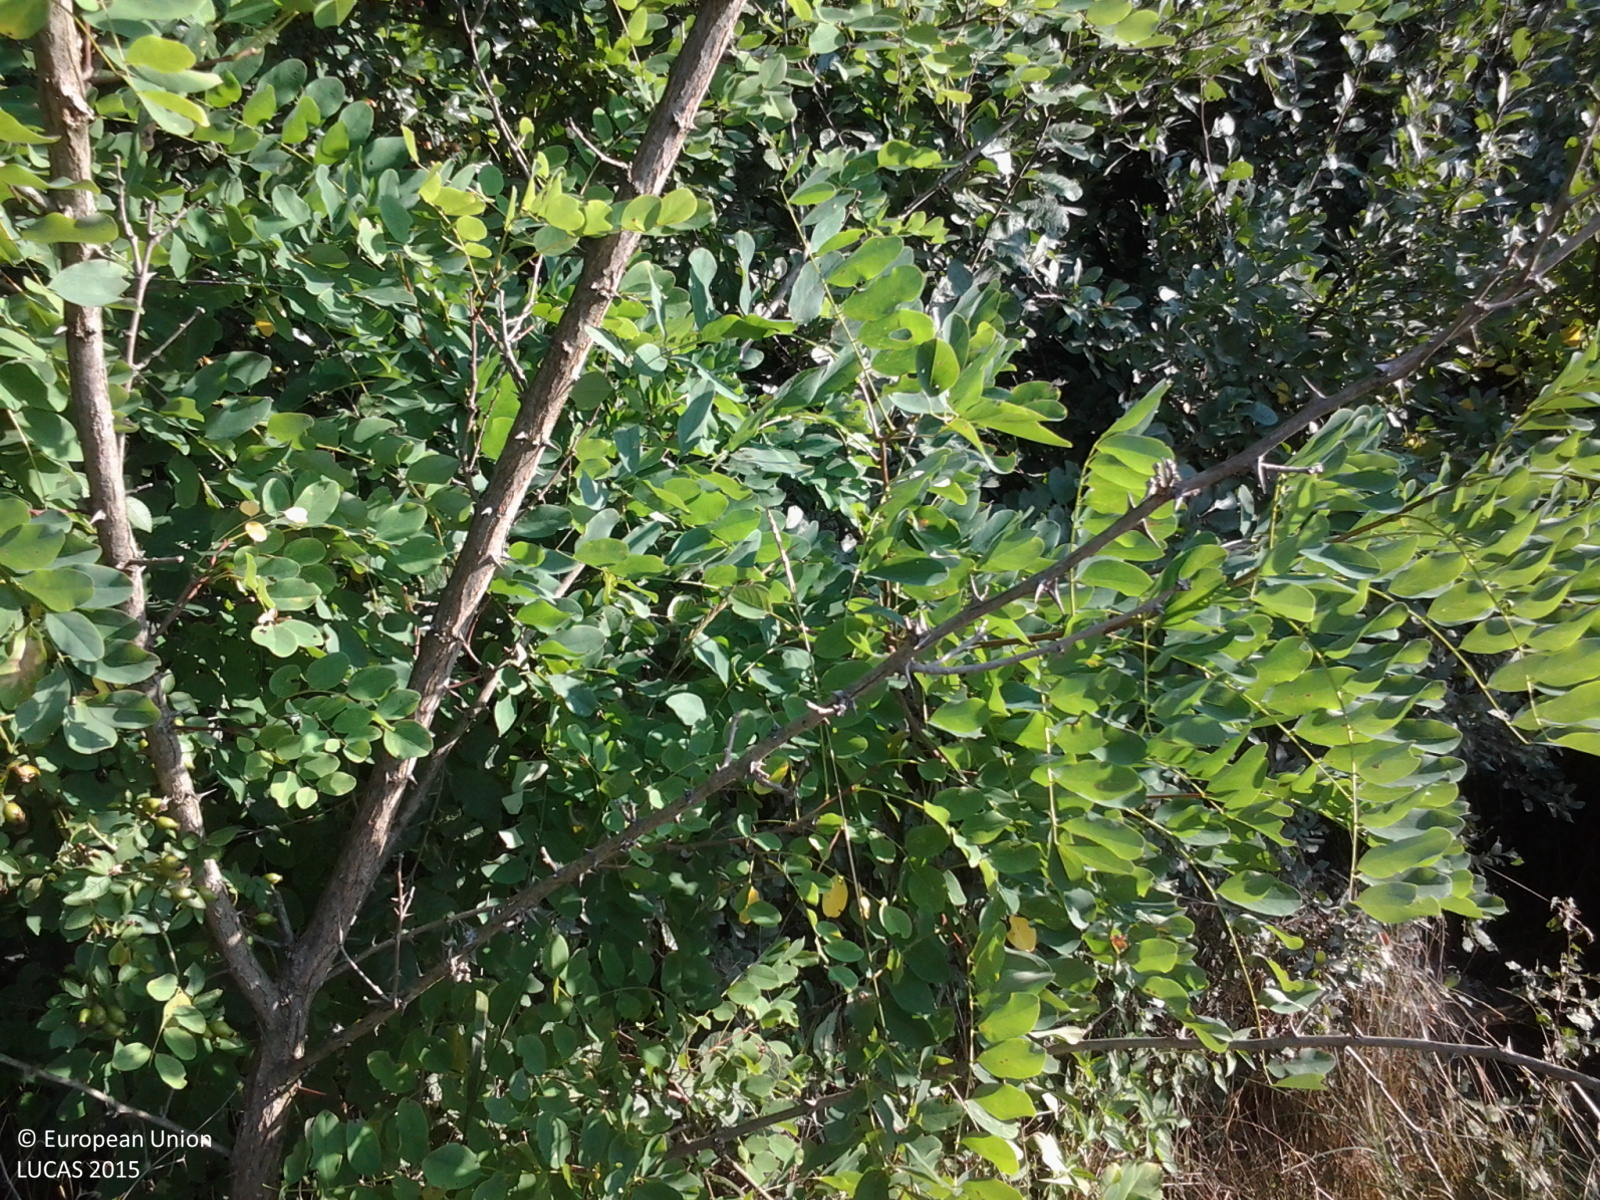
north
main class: Woodland
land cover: Broadleaved woodland
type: mesophytic deciduous forest
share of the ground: > 75 %
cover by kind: broadleaved forest trees 65 %, shrubs 20 %, herbaceous plants 15 %
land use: Forestry
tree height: < 5 m
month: August
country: HU
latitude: 46.8899
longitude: 21.5238
